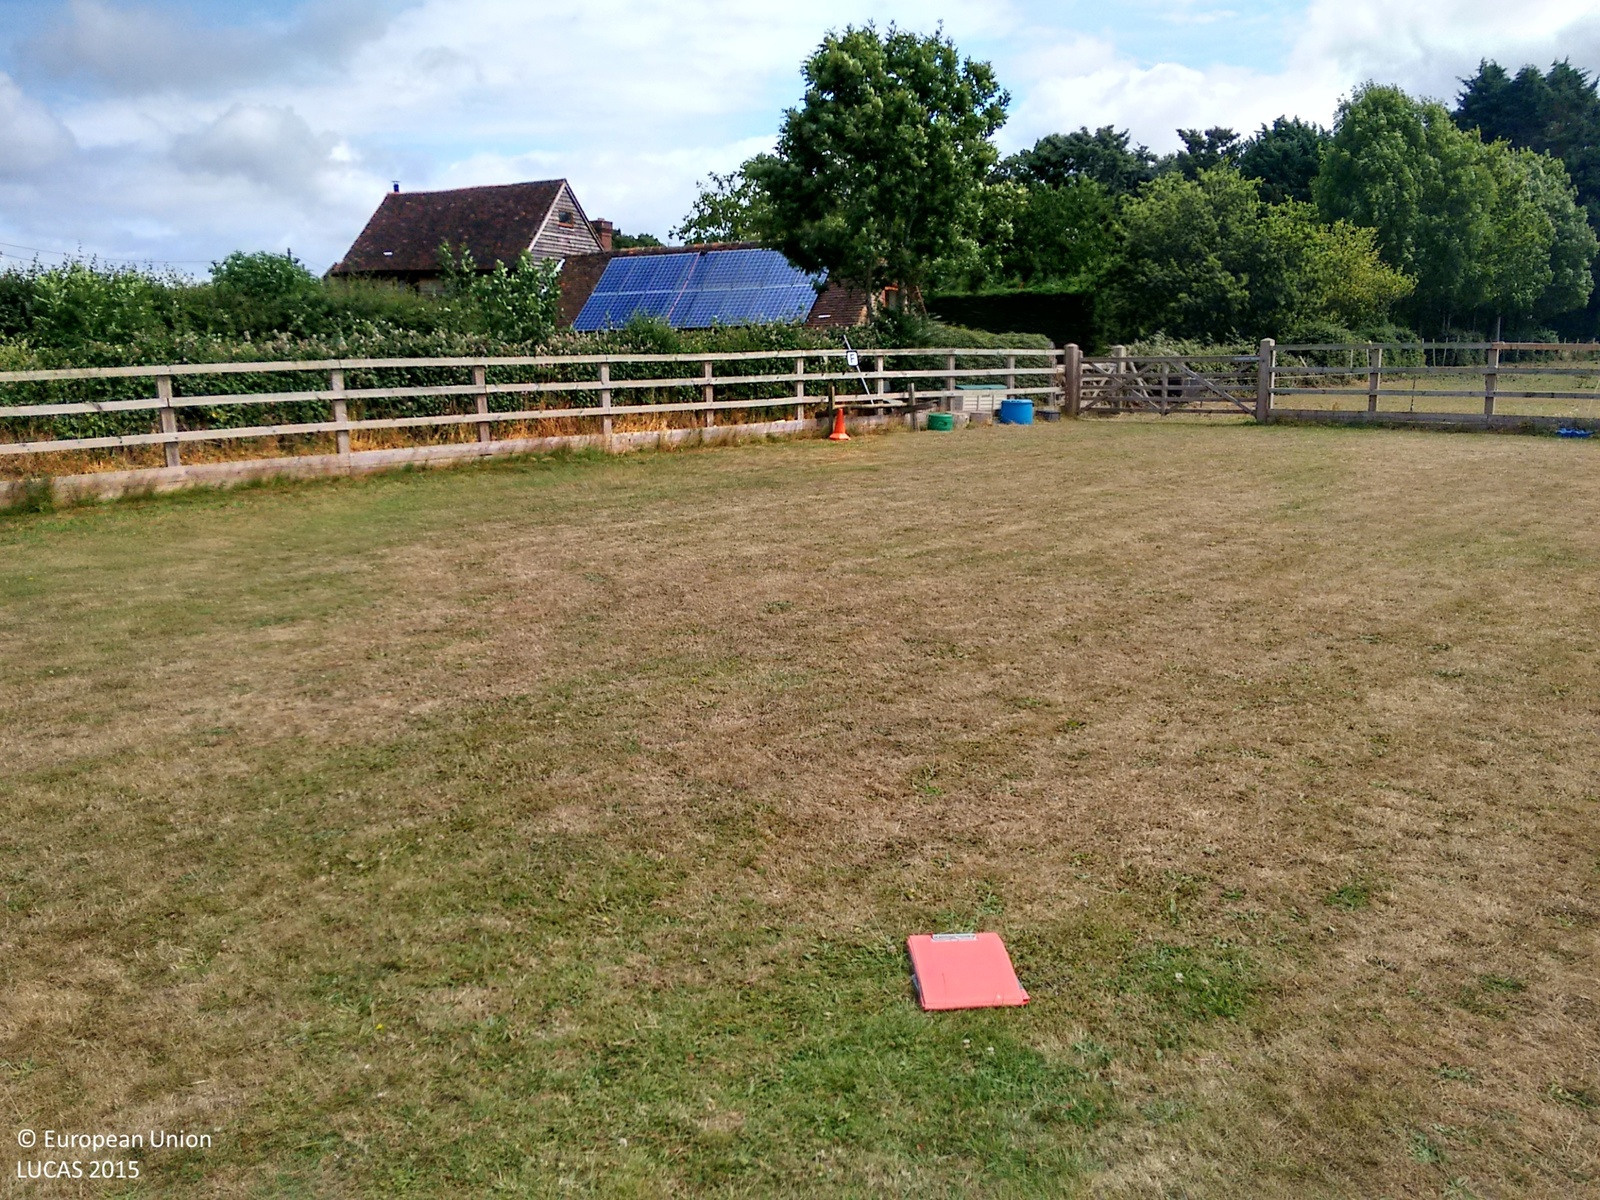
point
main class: Grassland
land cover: Grassland without tree/shrub cover
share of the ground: > 75 %
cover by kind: herbaceous plants 100 %
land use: Agriculture (excluding fallow land and kitchen gardens)
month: July
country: GB
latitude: 51.0840
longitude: -0.4157
